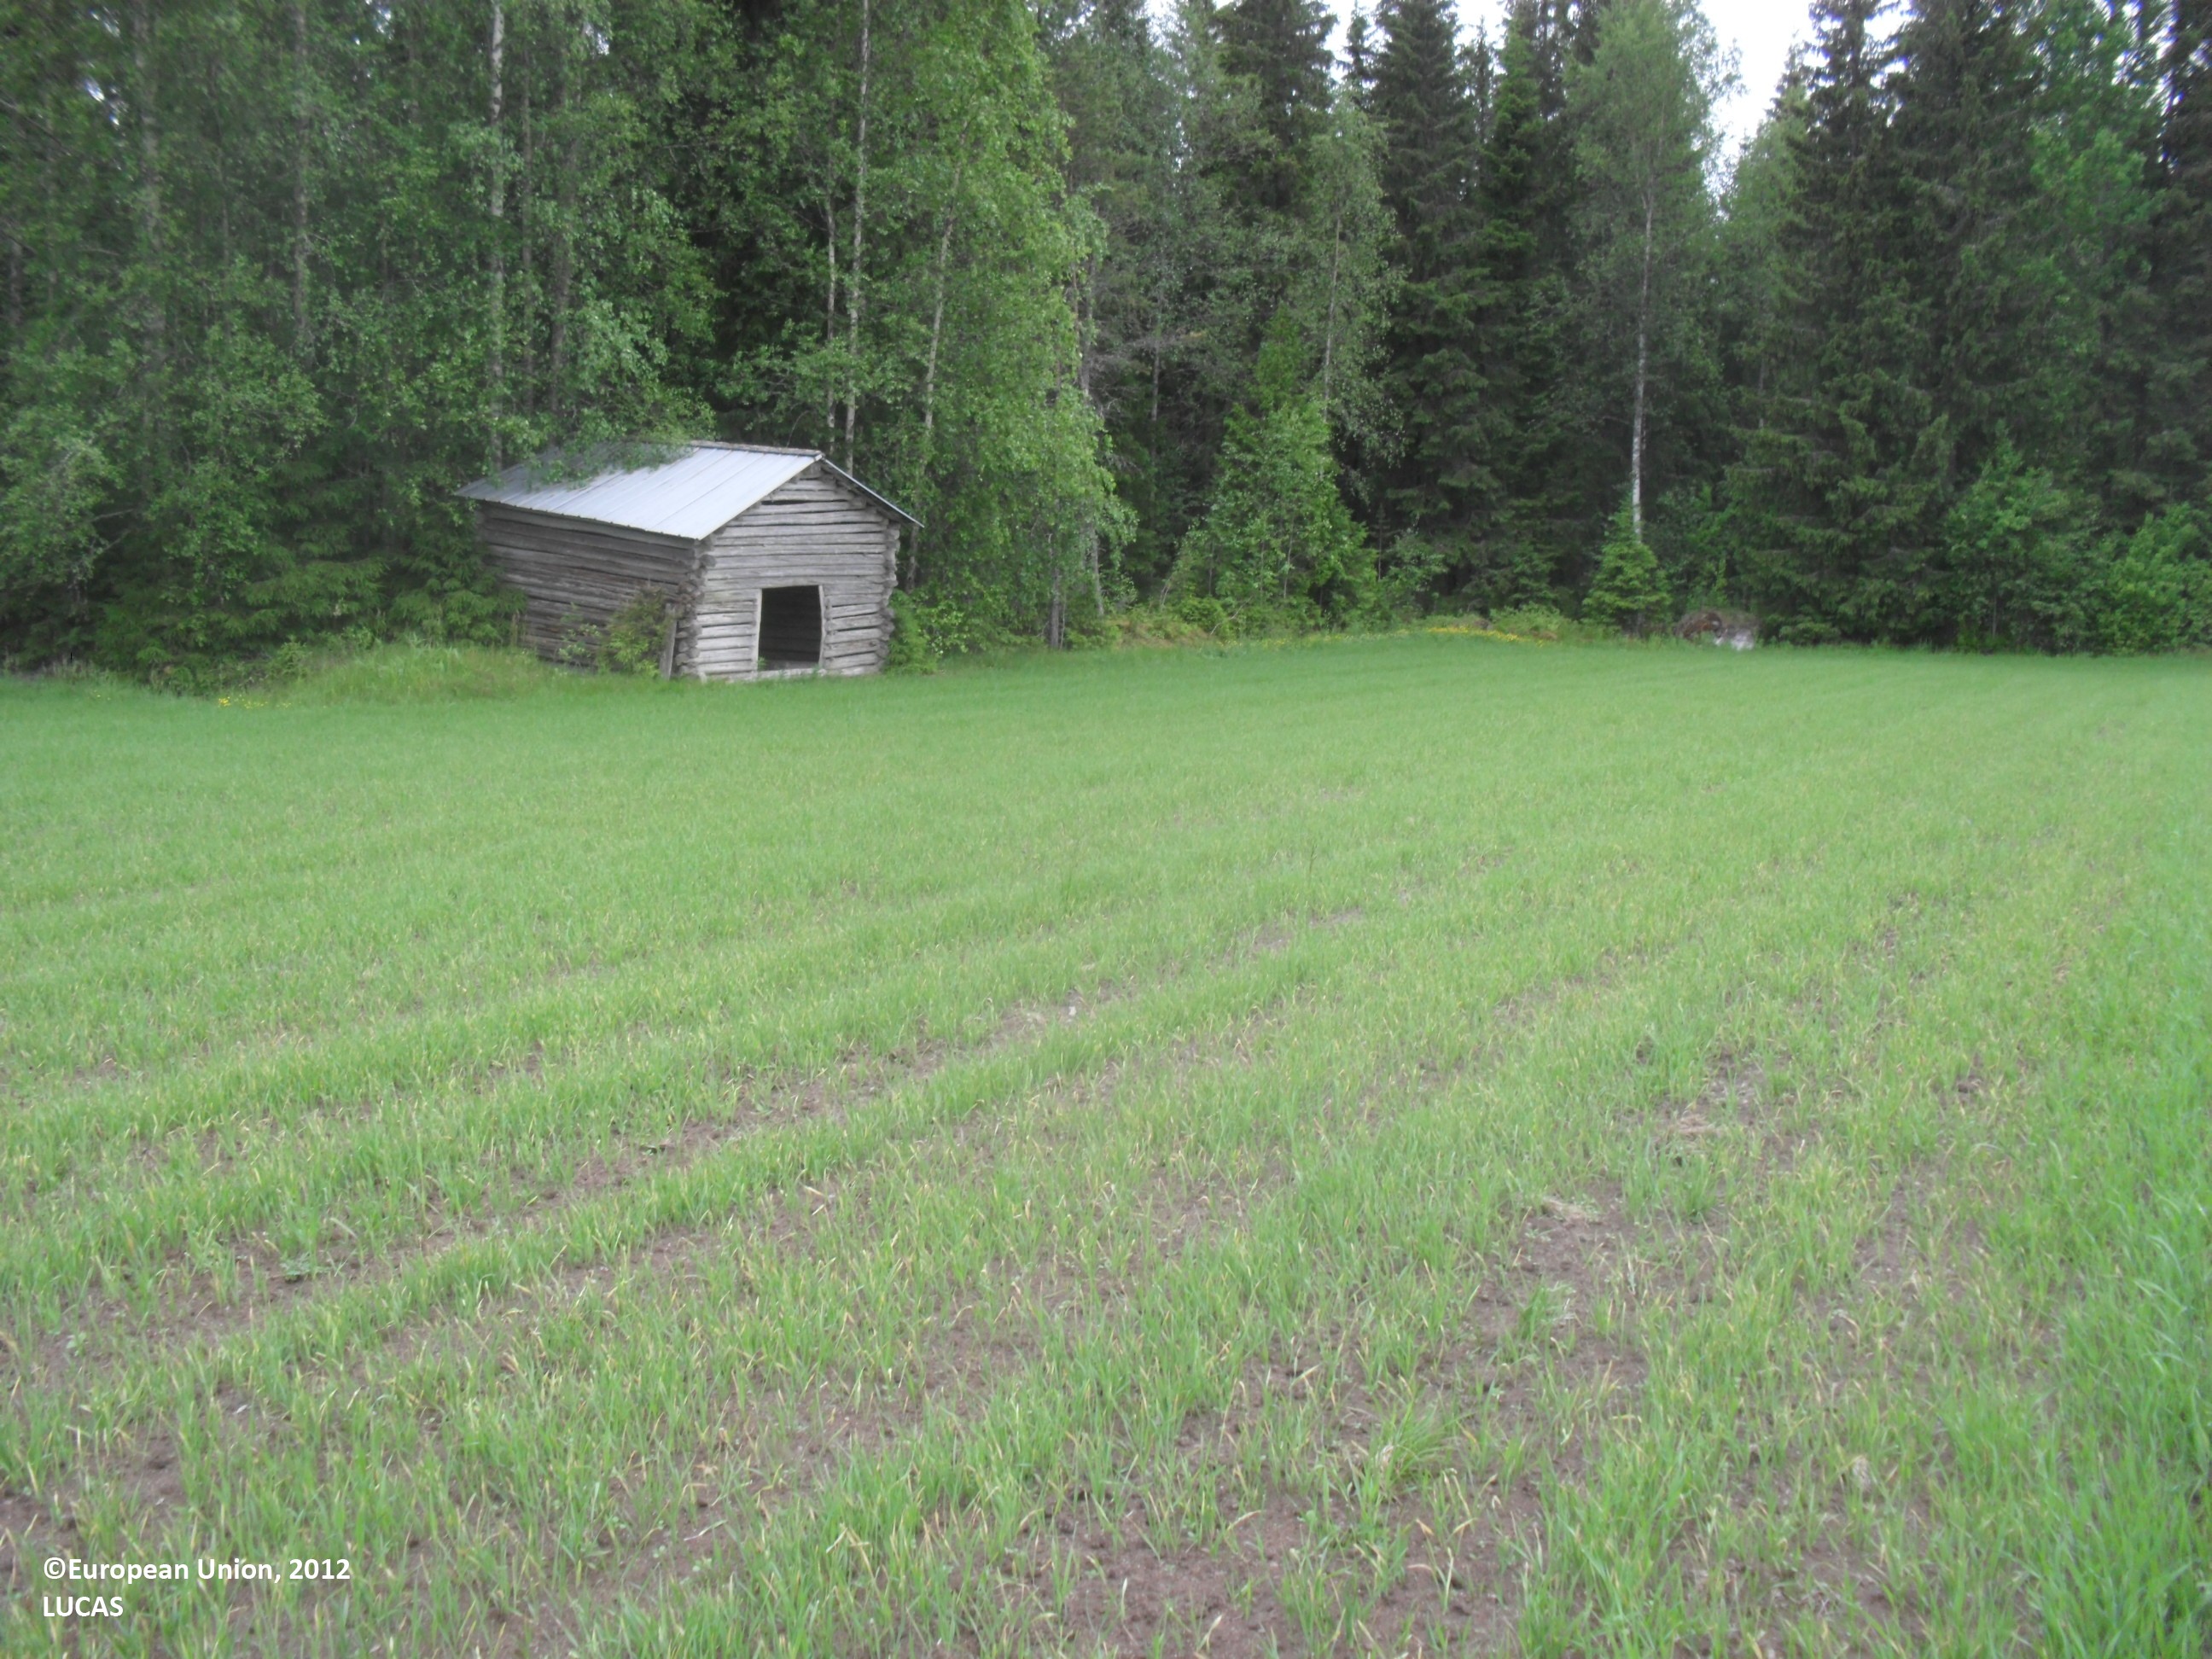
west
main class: Cropland
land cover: Barley
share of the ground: 10 - 25 %
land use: Agriculture (excluding fallow land and kitchen gardens)
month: June
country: FI
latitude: 63.4898
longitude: 23.0472
